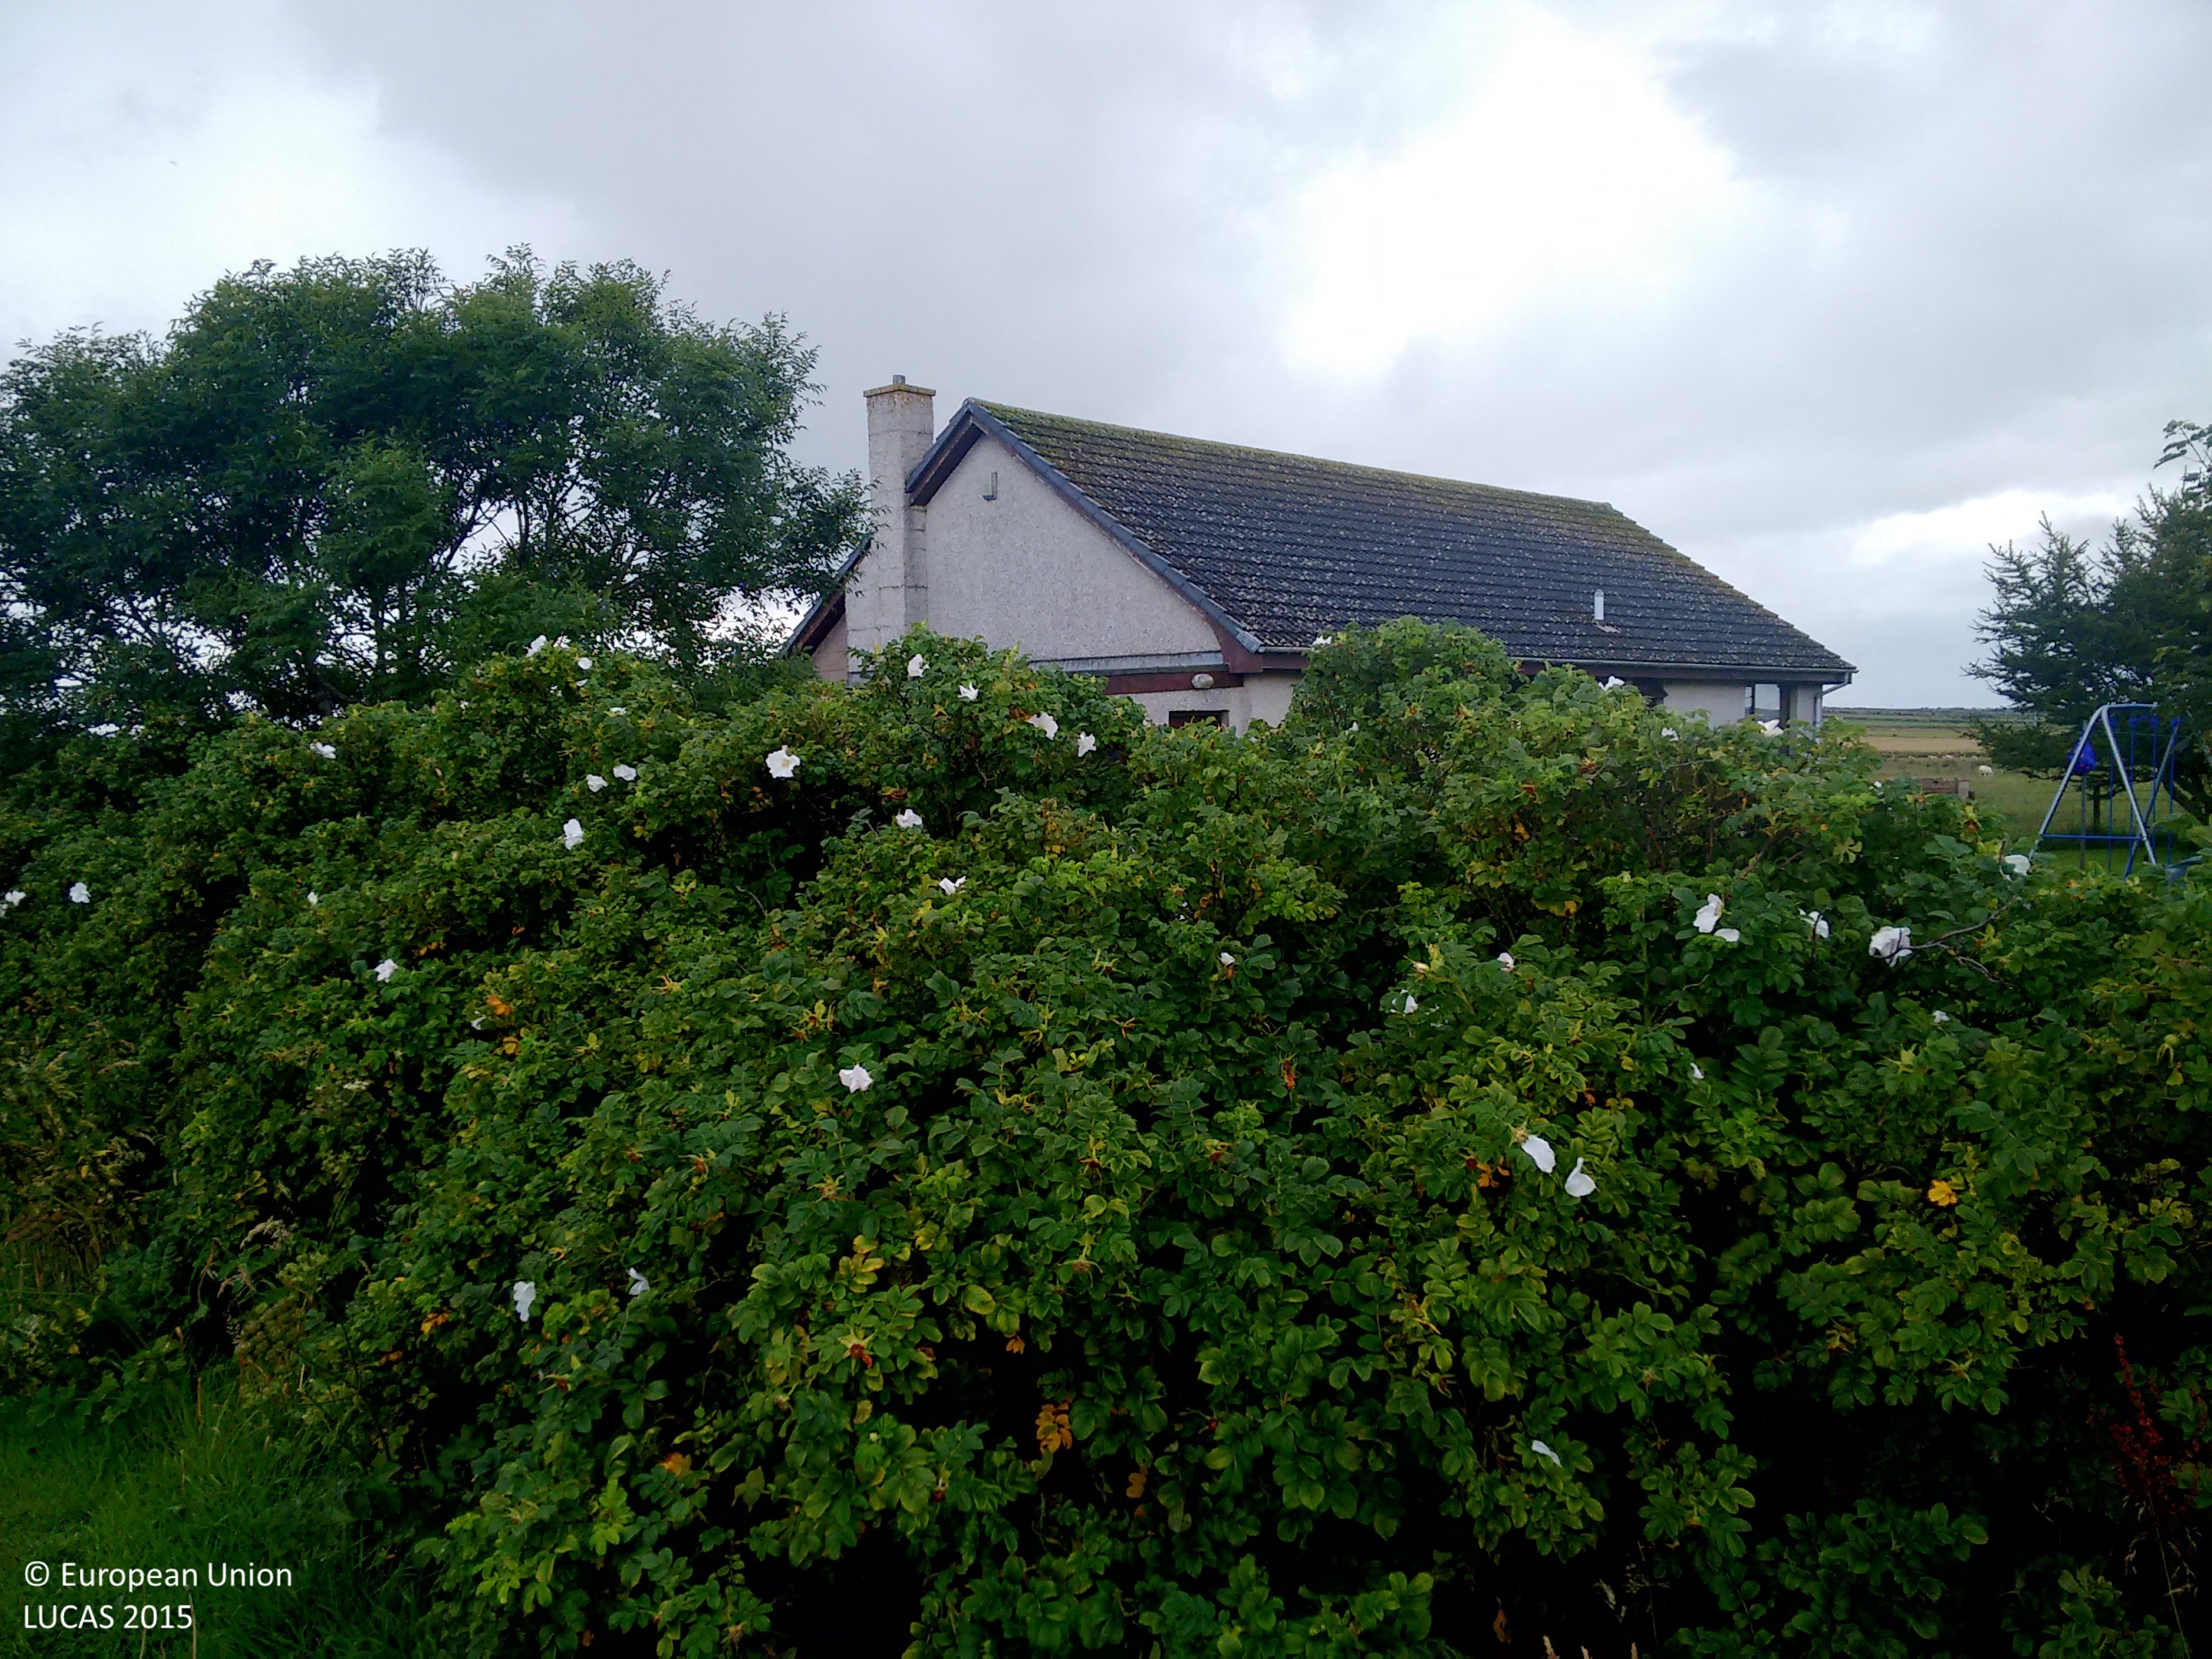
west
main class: Grassland
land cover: Grassland with sparse tree/shrub cover
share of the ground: > 75 %
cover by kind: herbaceous plants 85 %, shrubs 10 %, broadleaved forest trees 5 %
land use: Residential
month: August
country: GB
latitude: 58.5507
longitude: -3.2047
